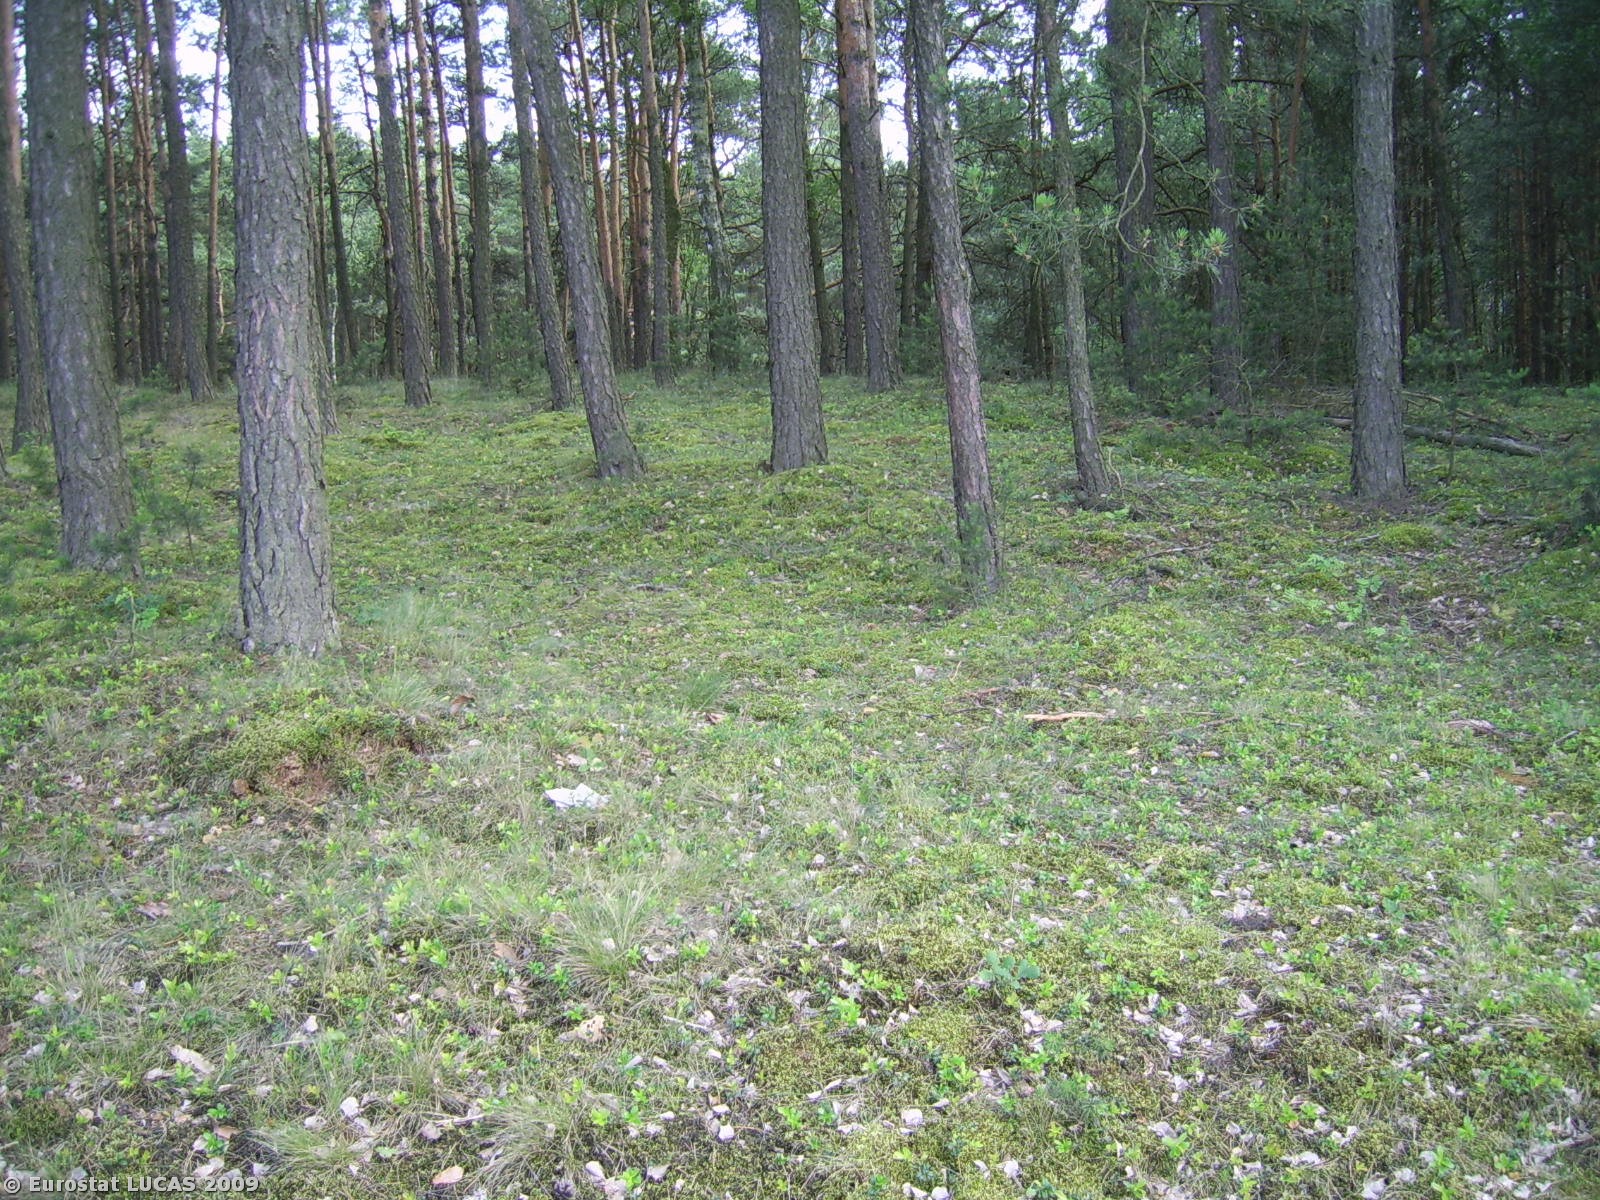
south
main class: Cropland
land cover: Oats
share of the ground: > 75 %
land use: Agriculture (excluding fallow land and kitchen gardens)
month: June
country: PL
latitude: 52.1029
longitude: 17.7959
